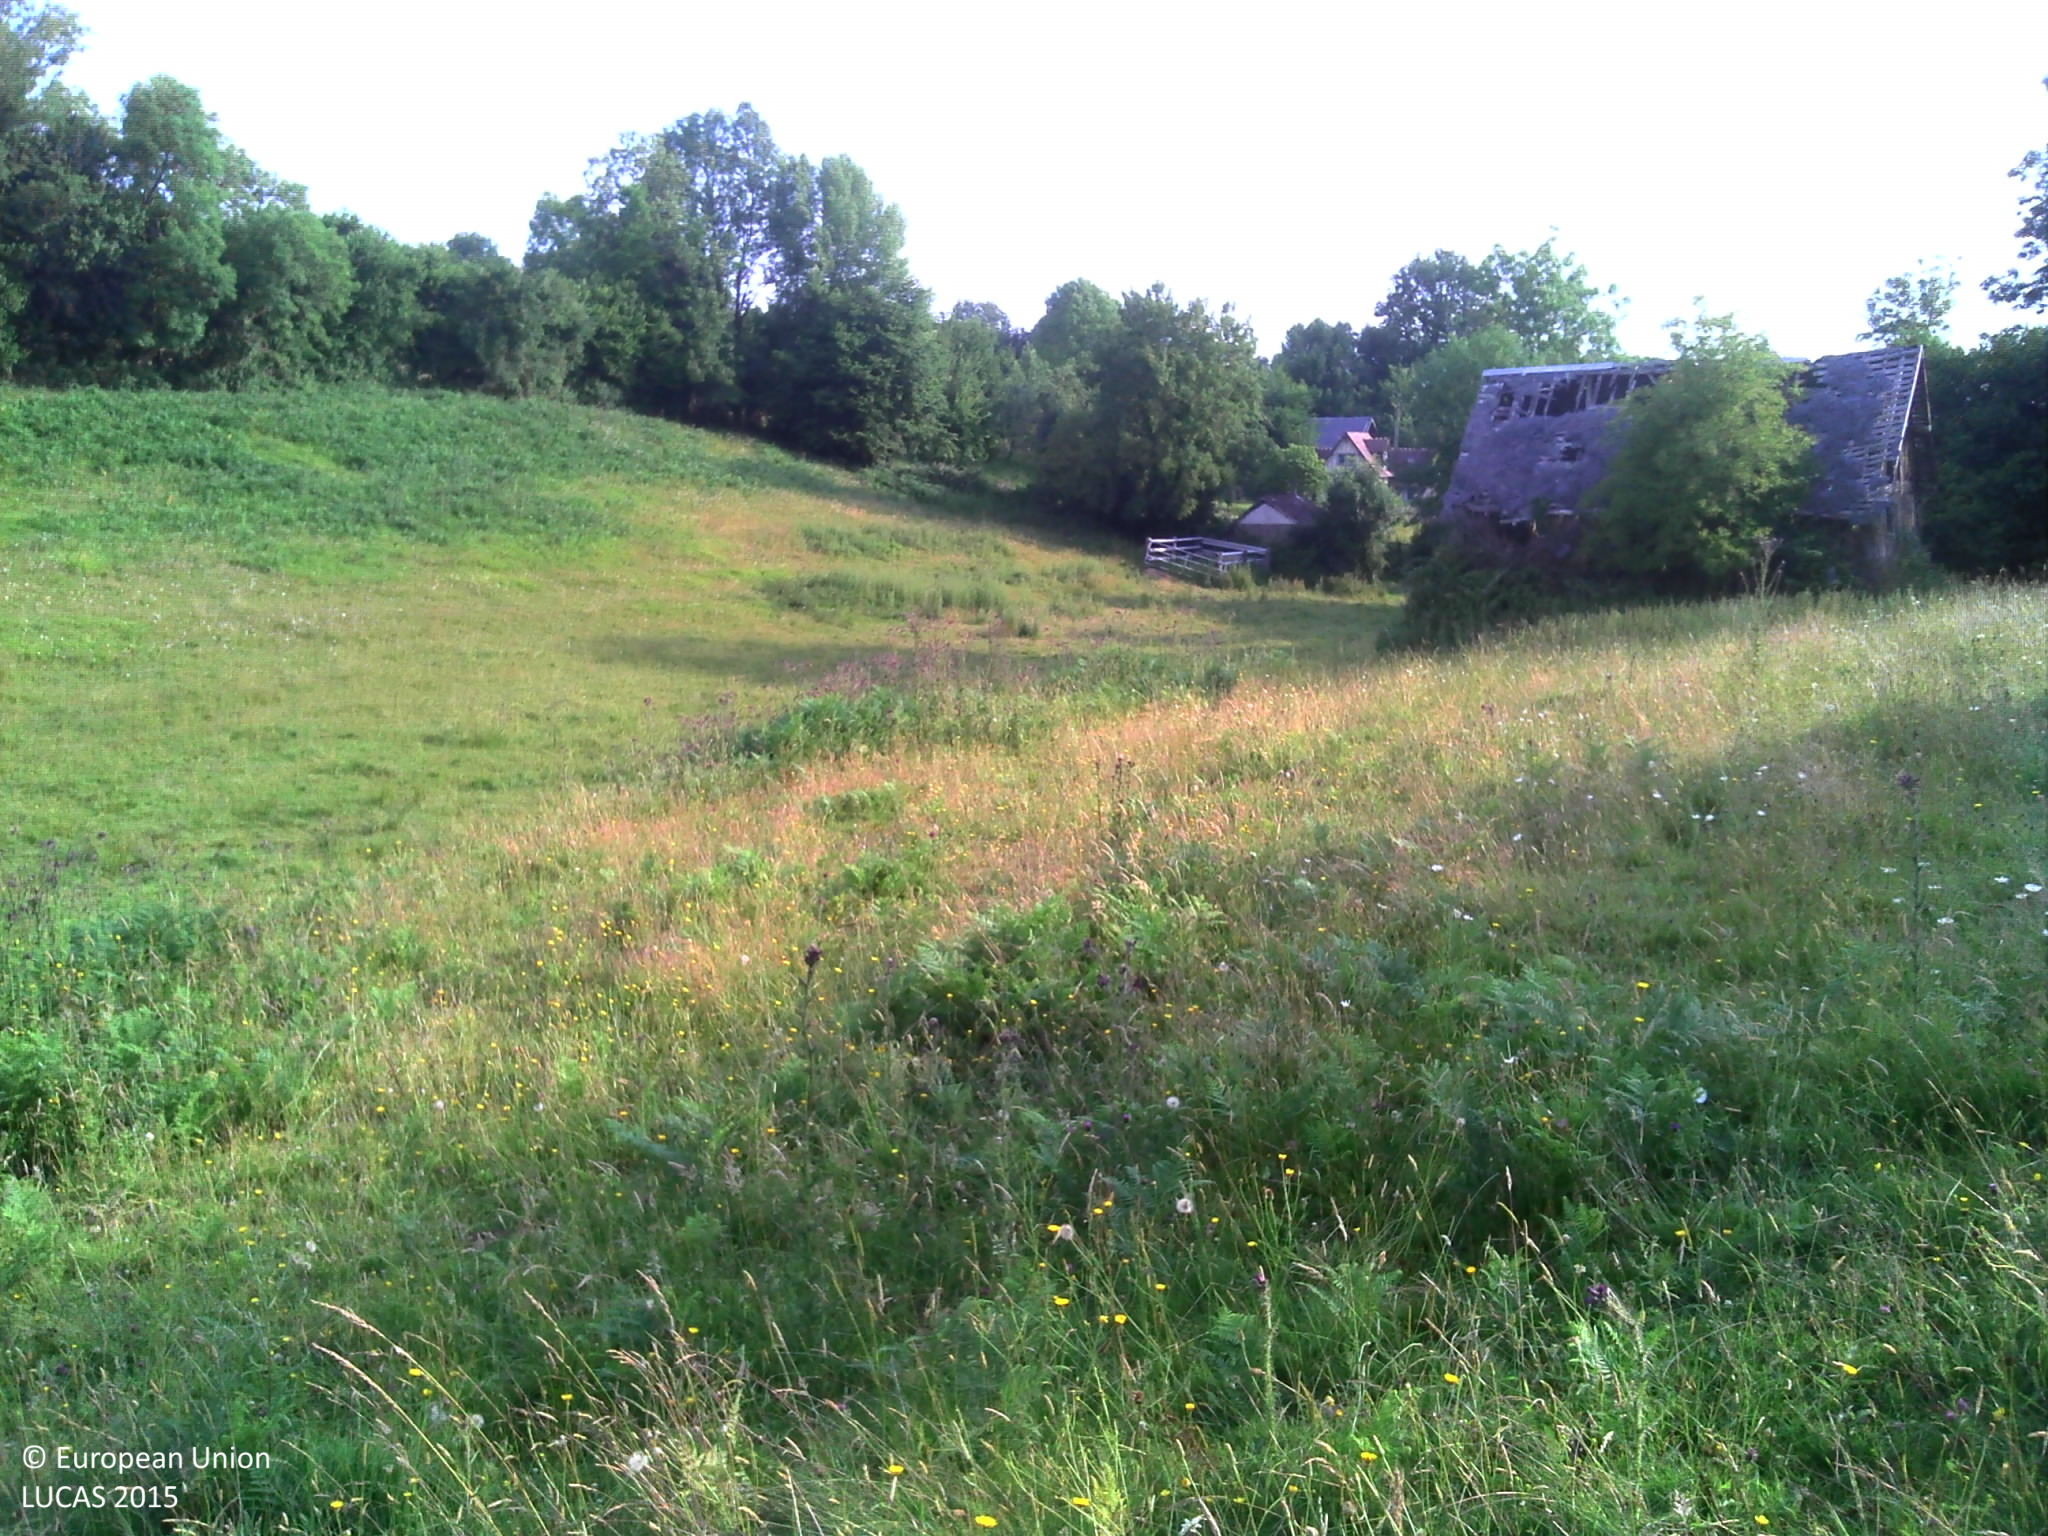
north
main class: Grassland
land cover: Grassland without tree/shrub cover
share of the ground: > 75 %
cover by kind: herbaceous plants 100 %
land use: Agriculture (excluding fallow land and kitchen gardens)
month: July
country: FR
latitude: 48.9903
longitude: 0.0895
